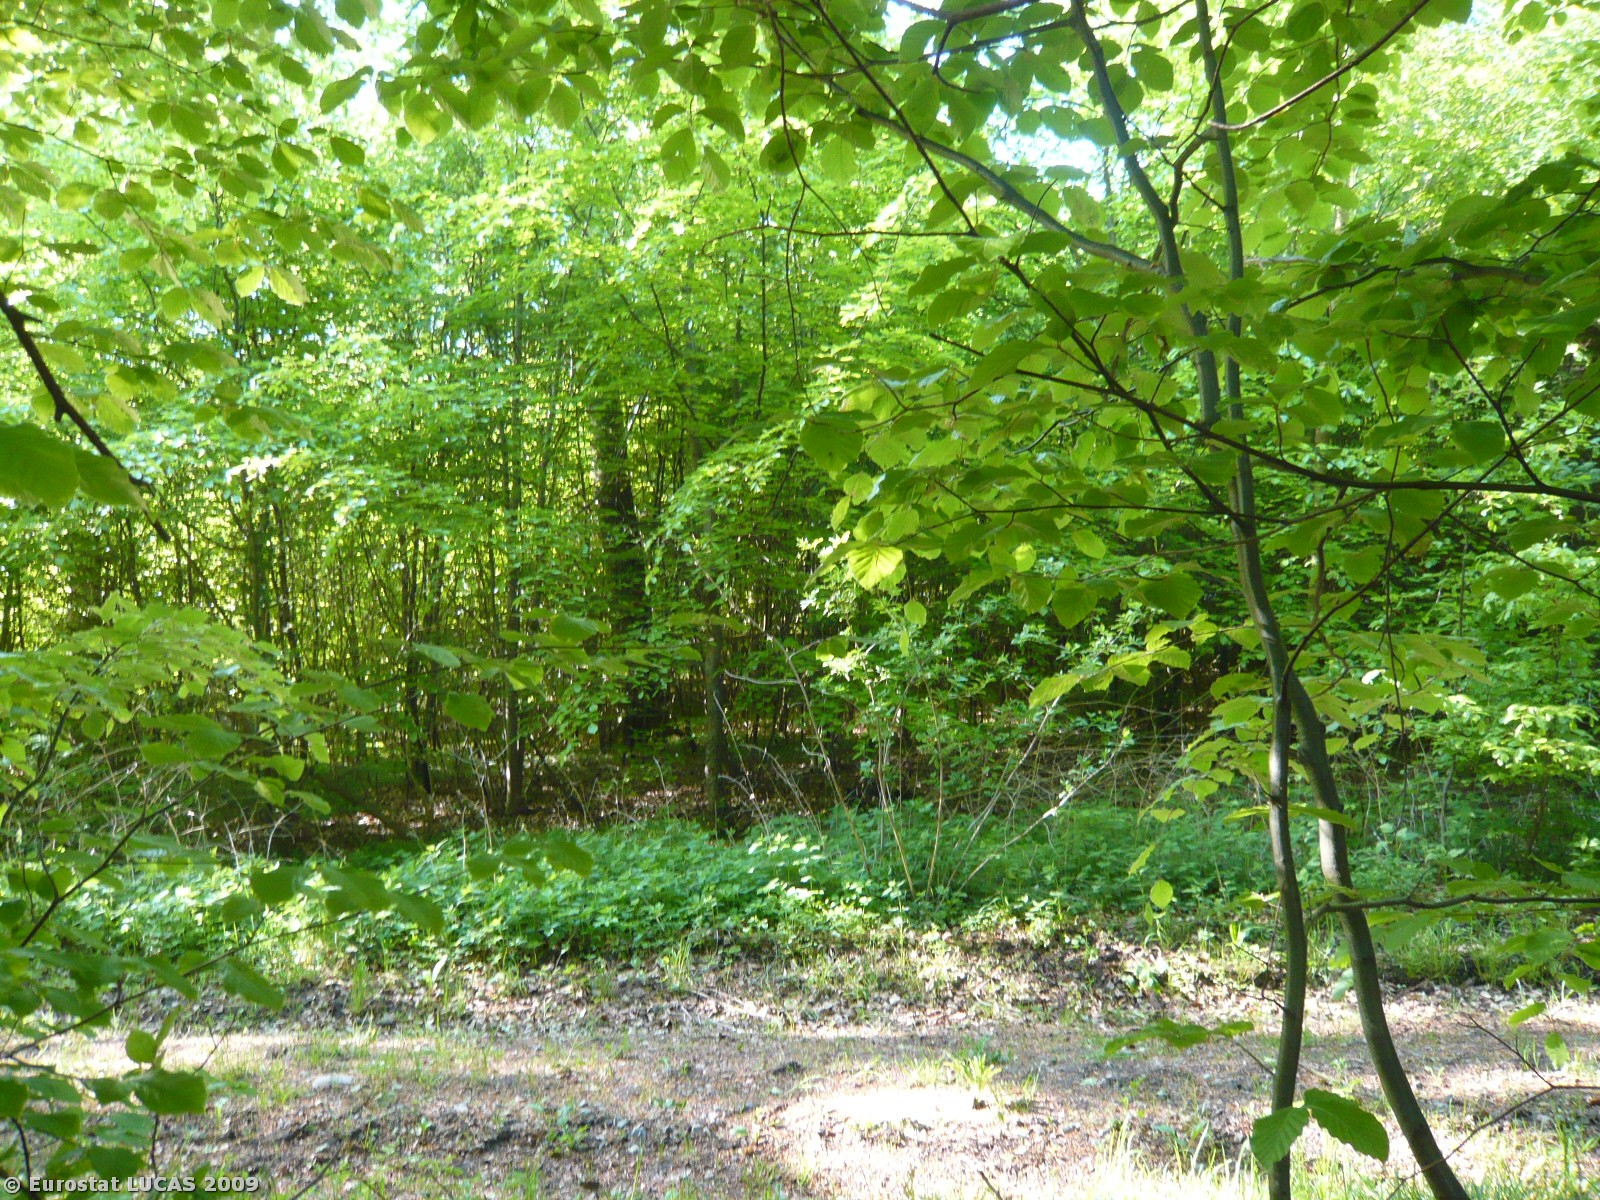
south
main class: Woodland
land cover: Broadleaved woodland
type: mesophytic deciduous forest
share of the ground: > 75 %
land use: Forestry
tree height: > 5 m
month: May
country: DK
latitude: 55.0920
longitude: 12.0825
